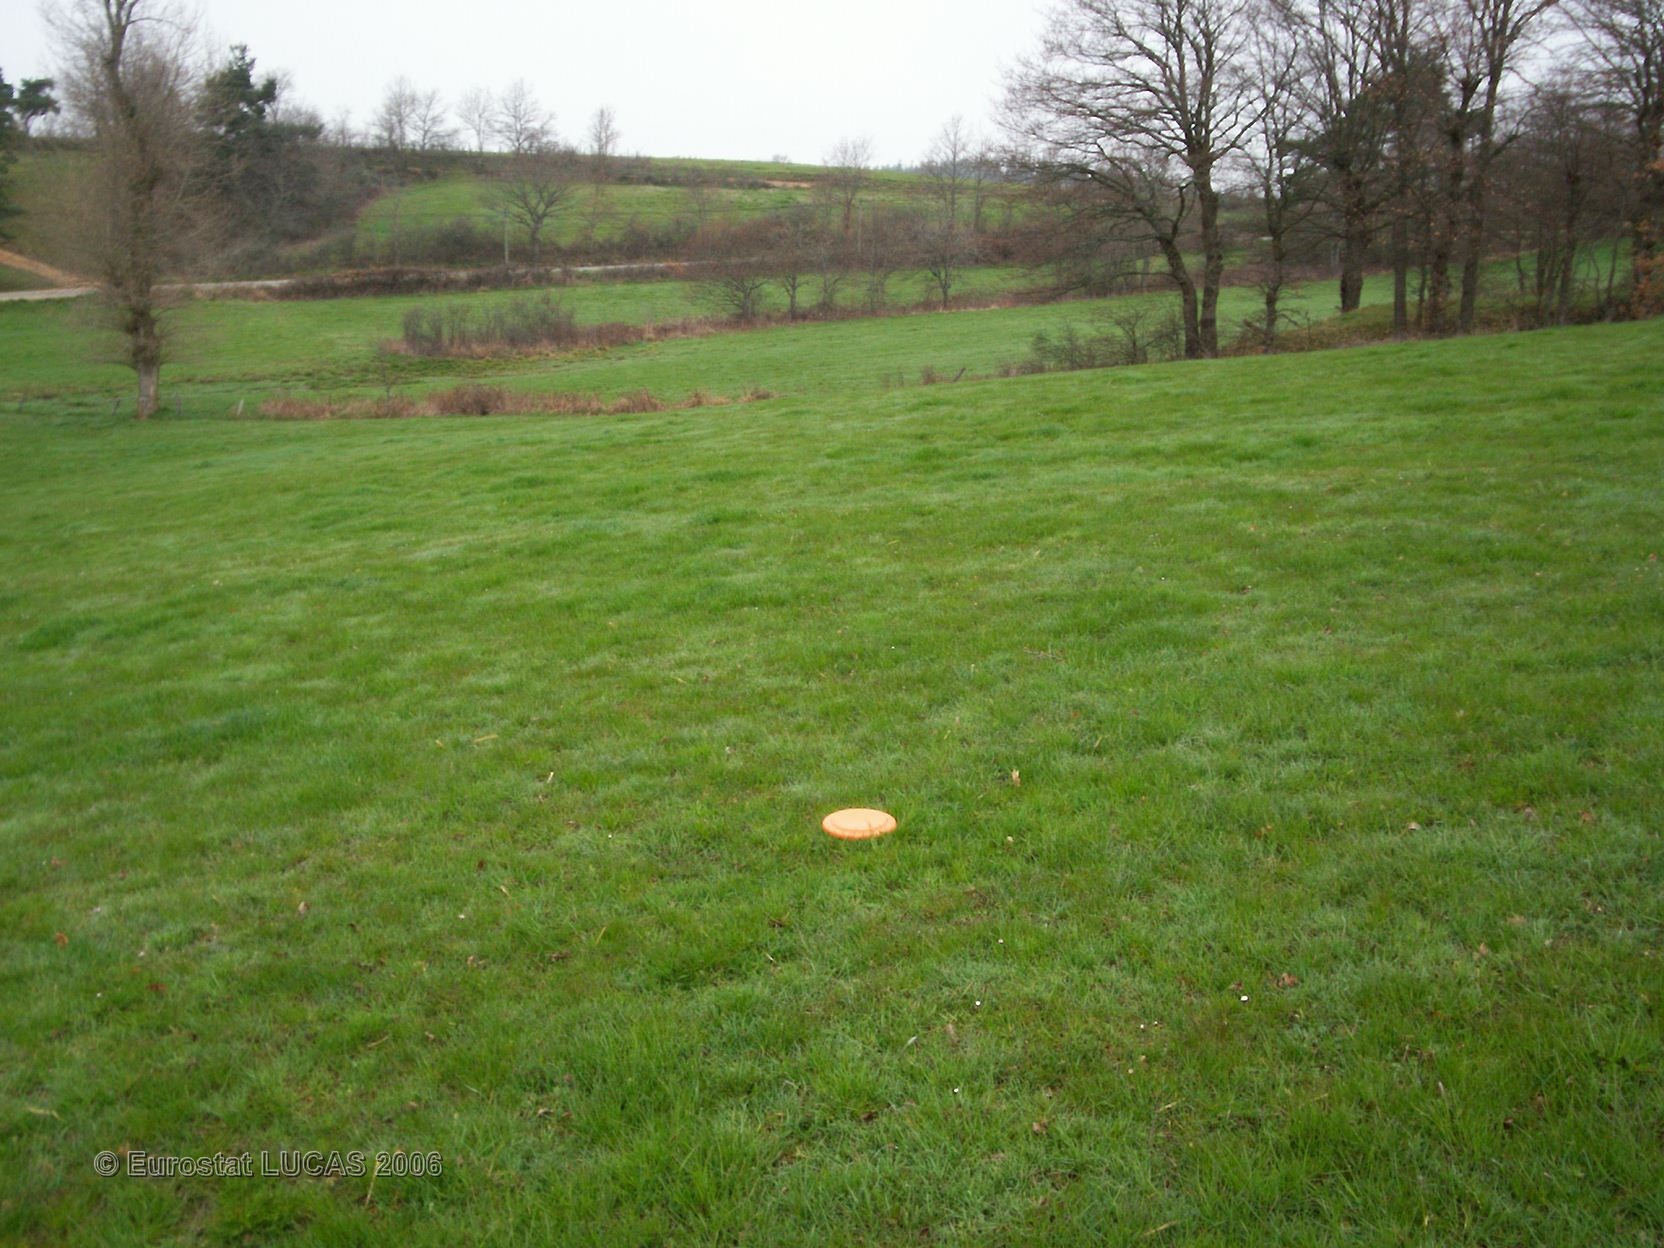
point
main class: Grassland
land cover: Grassland without tree/shrub cover
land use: Agriculture (excluding fallow land and kitchen gardens)
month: April
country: FR
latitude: 44.9462
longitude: 3.2732
